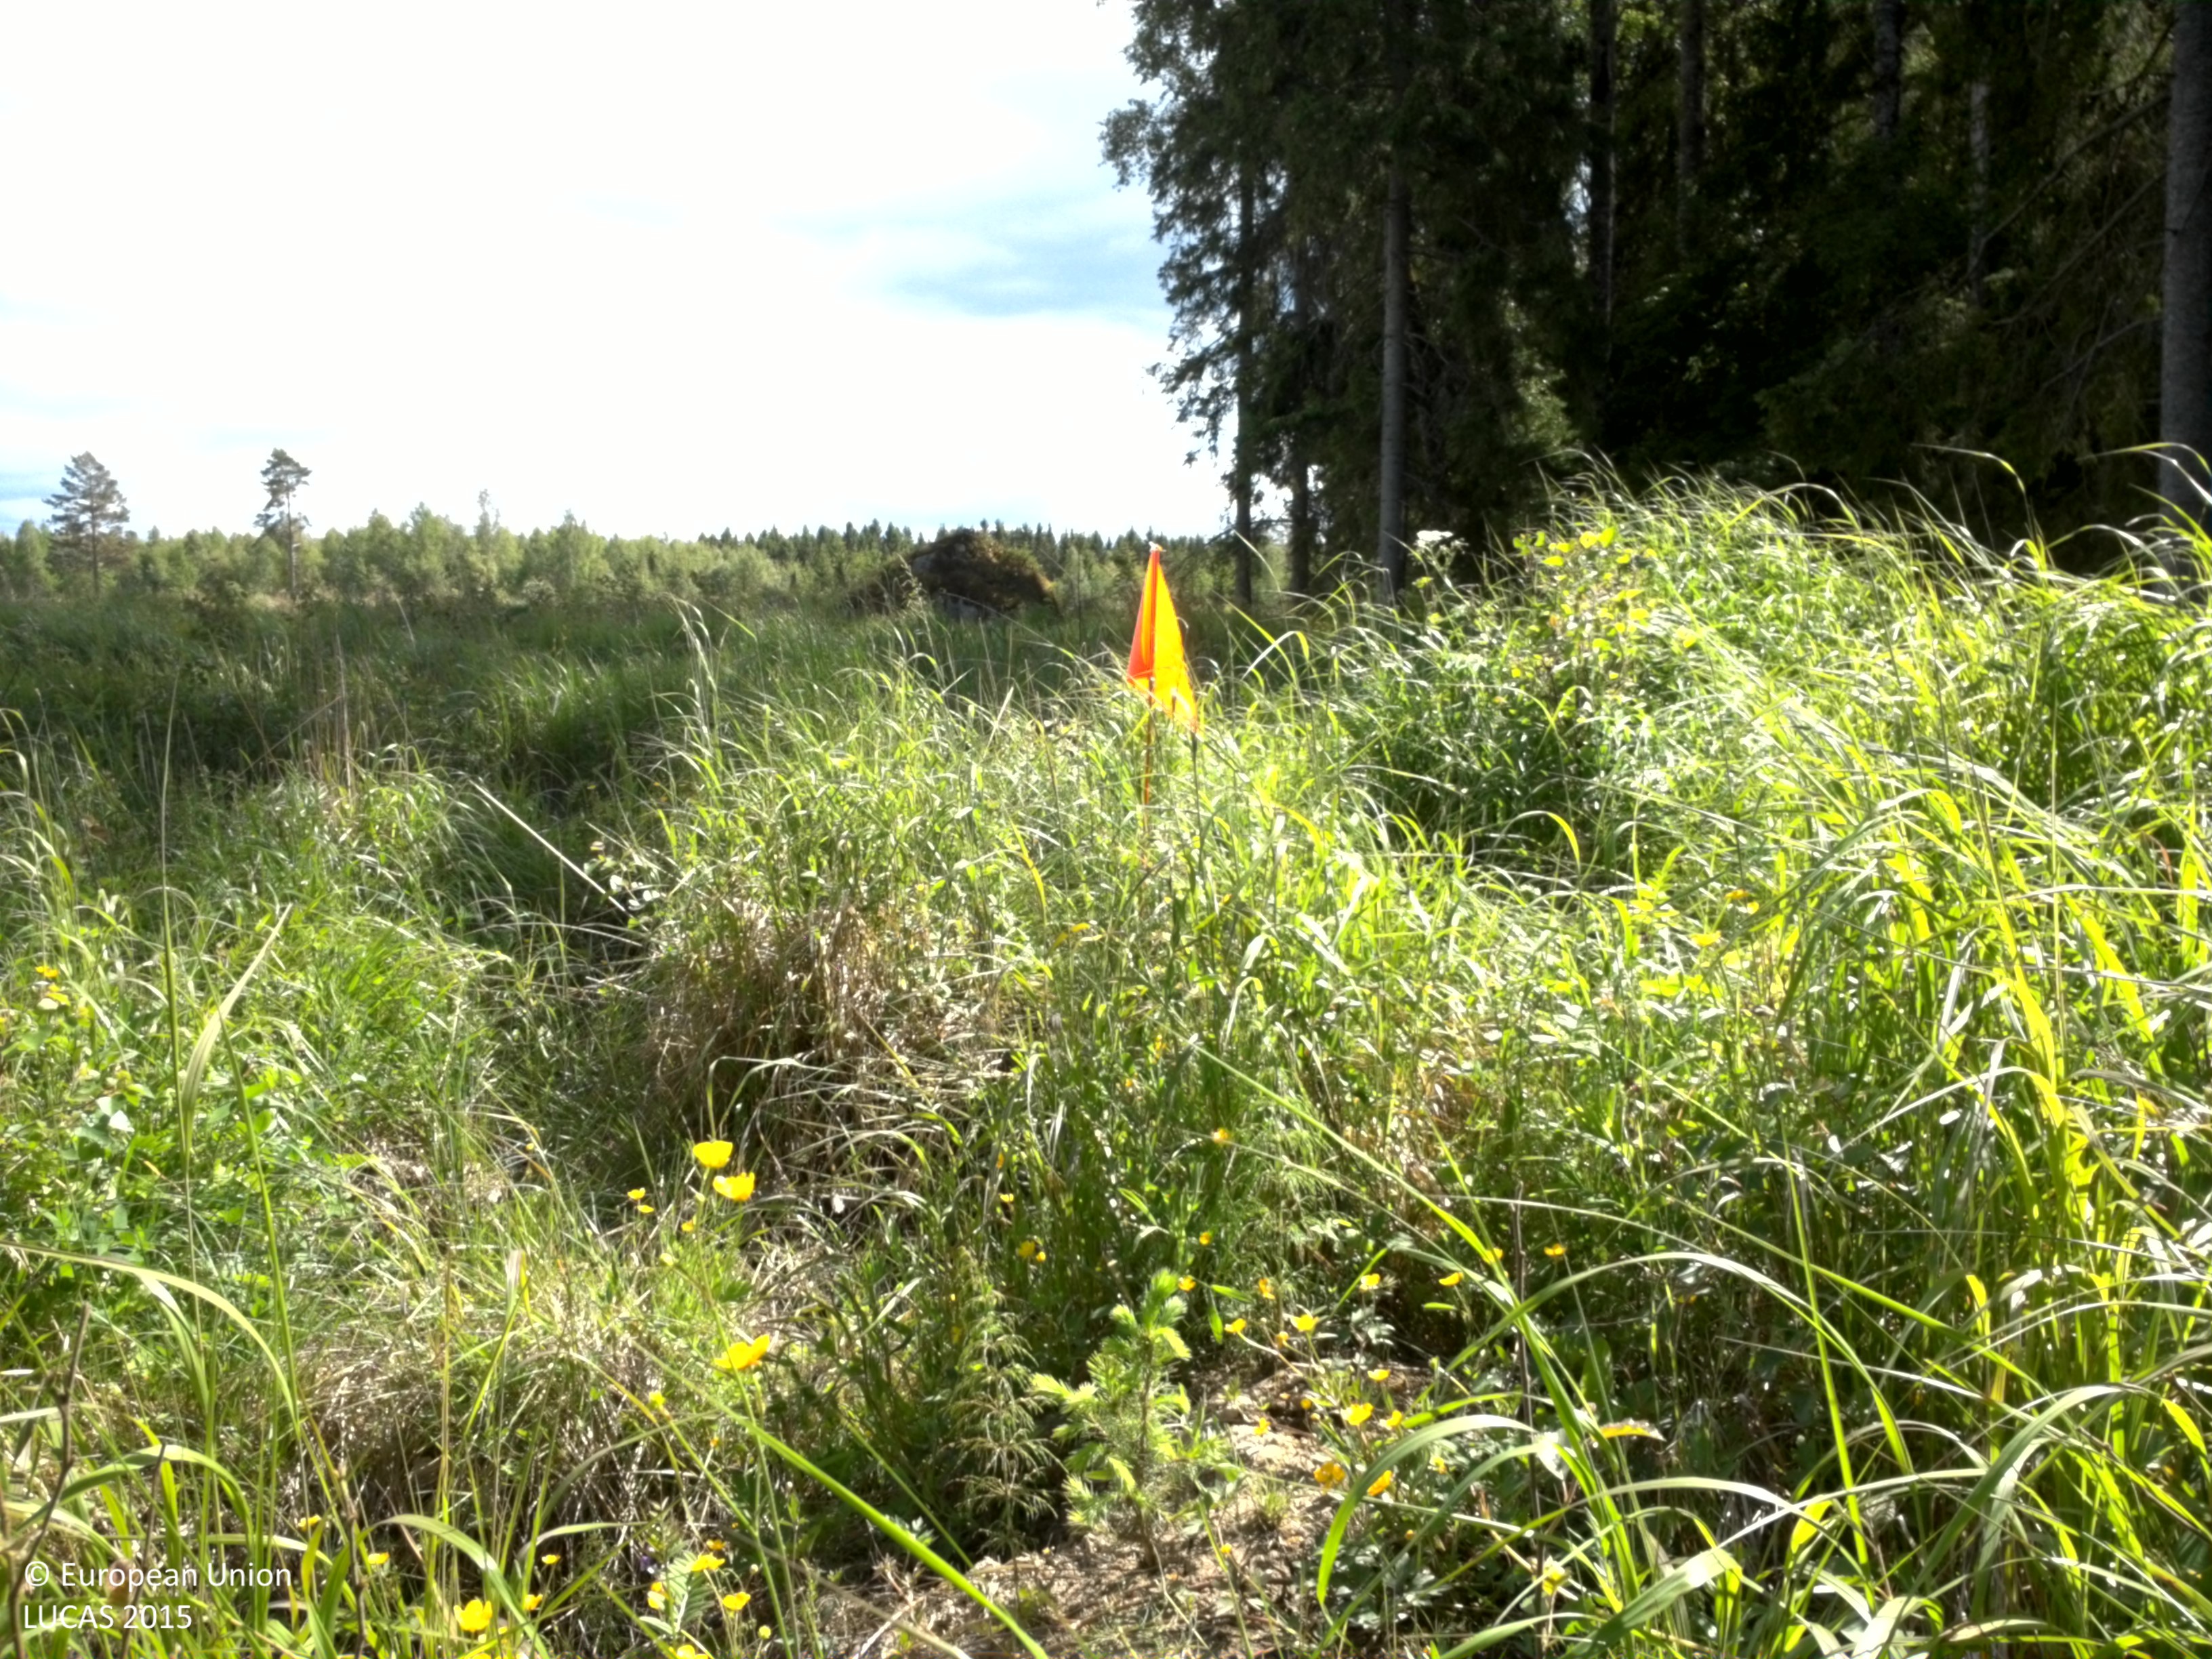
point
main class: Grassland
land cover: Grassland with sparse tree/shrub cover
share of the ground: < 10 %
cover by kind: herbaceous plants 80 %, unconsolidated bare surface 15 %, broadleaved forest trees 5 %
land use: Forestry
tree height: > 5 m
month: June
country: SE
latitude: 60.1838
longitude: 17.0770
